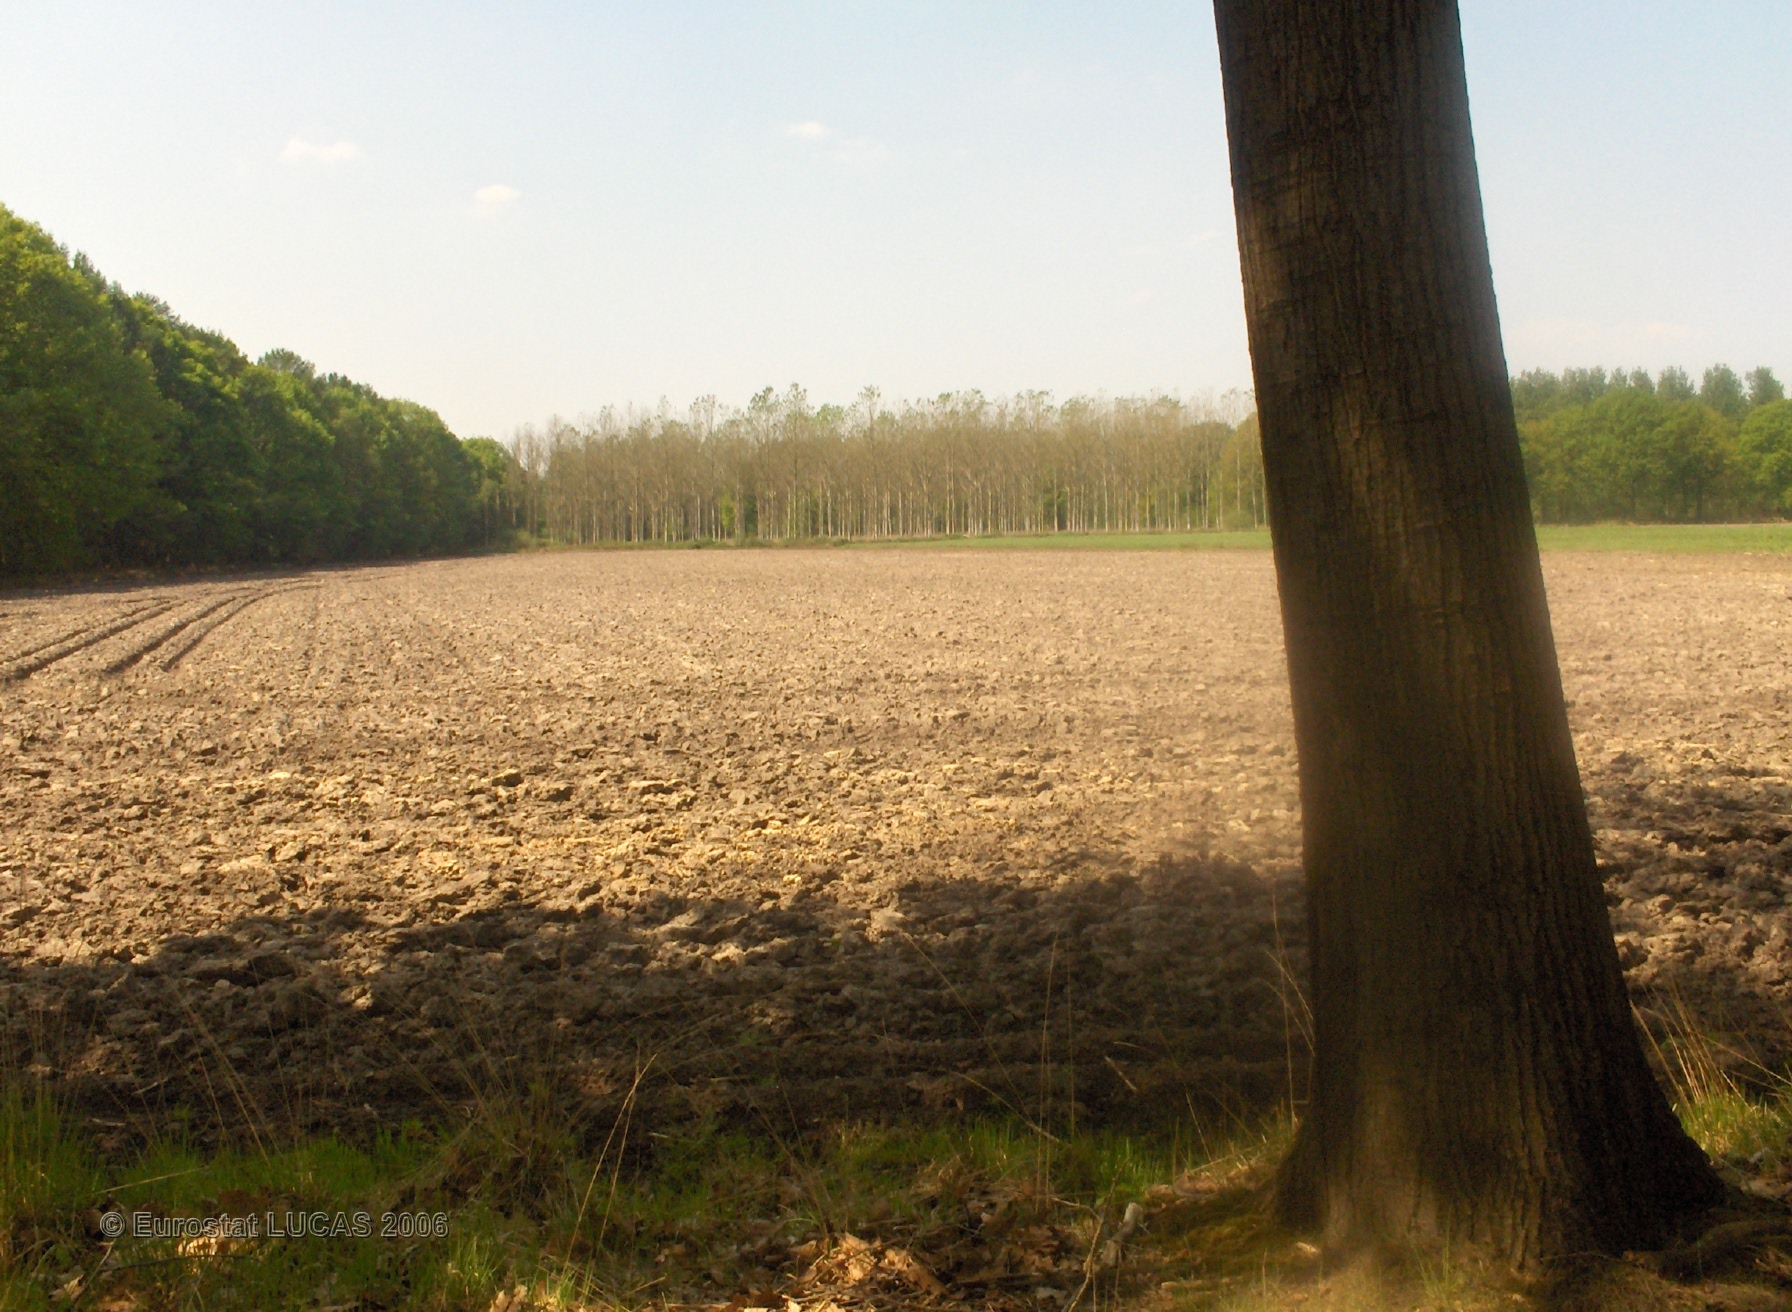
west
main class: Artificial land
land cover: Non built-up linear features
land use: Road transport
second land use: Agriculture (excluding fallow land and kitchen gardens)
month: May
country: BE
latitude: 51.2706
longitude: 5.1671
